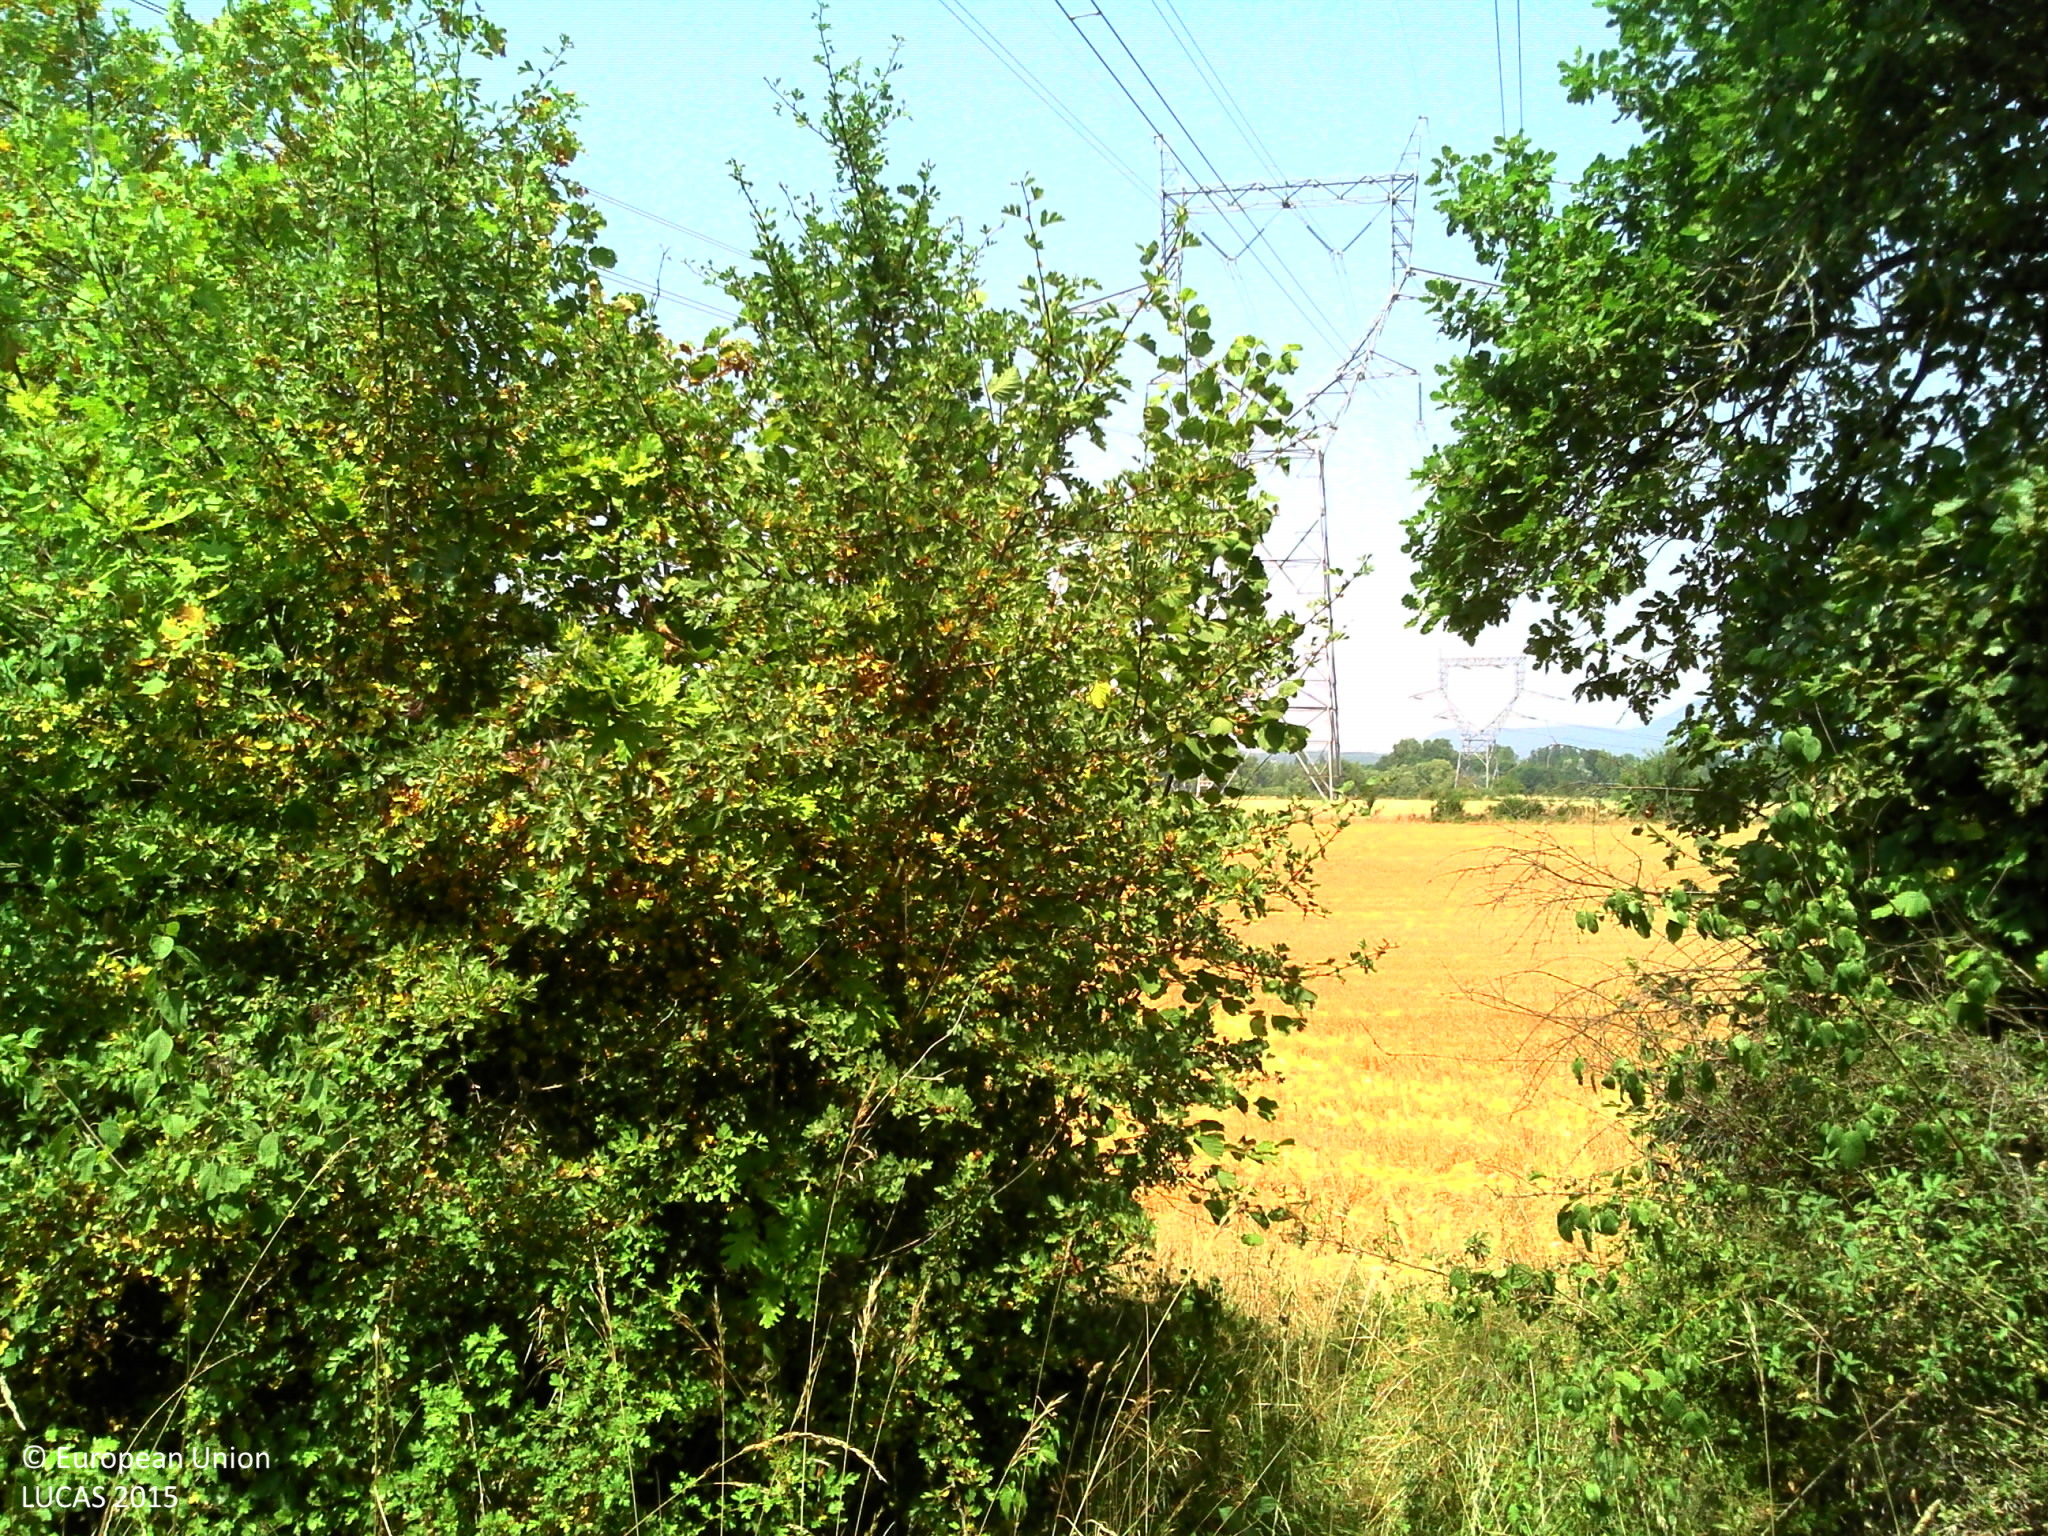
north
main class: Woodland
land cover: Broadleaved woodland
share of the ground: > 75 %
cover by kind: broadleaved forest trees 90 %, herbaceous plants 10 %
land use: Forestry
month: July
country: FR
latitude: 45.8028
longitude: 5.4363
